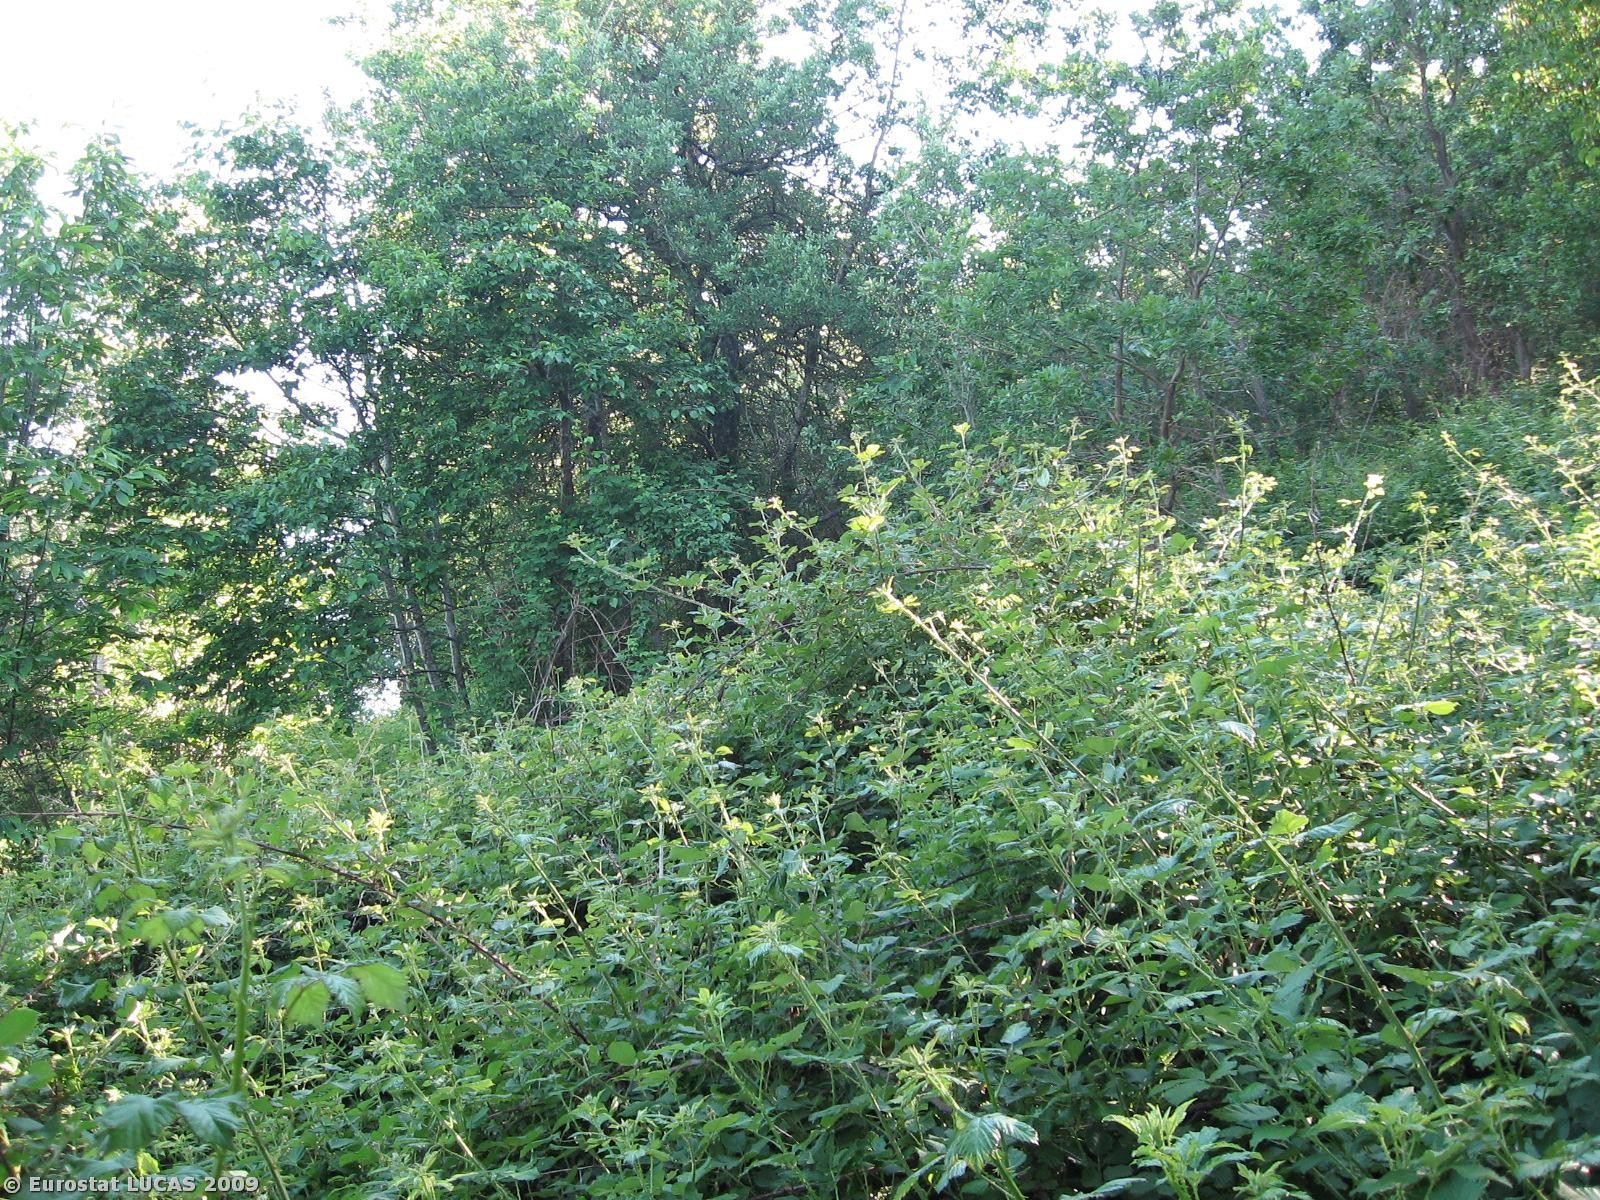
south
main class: Woodland
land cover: Broadleaved woodland
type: thermophilous deciduous forest
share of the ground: 50 - 75 %
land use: Forestry
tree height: > 5 m
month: June
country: IT
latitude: 39.0125
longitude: 16.2846
